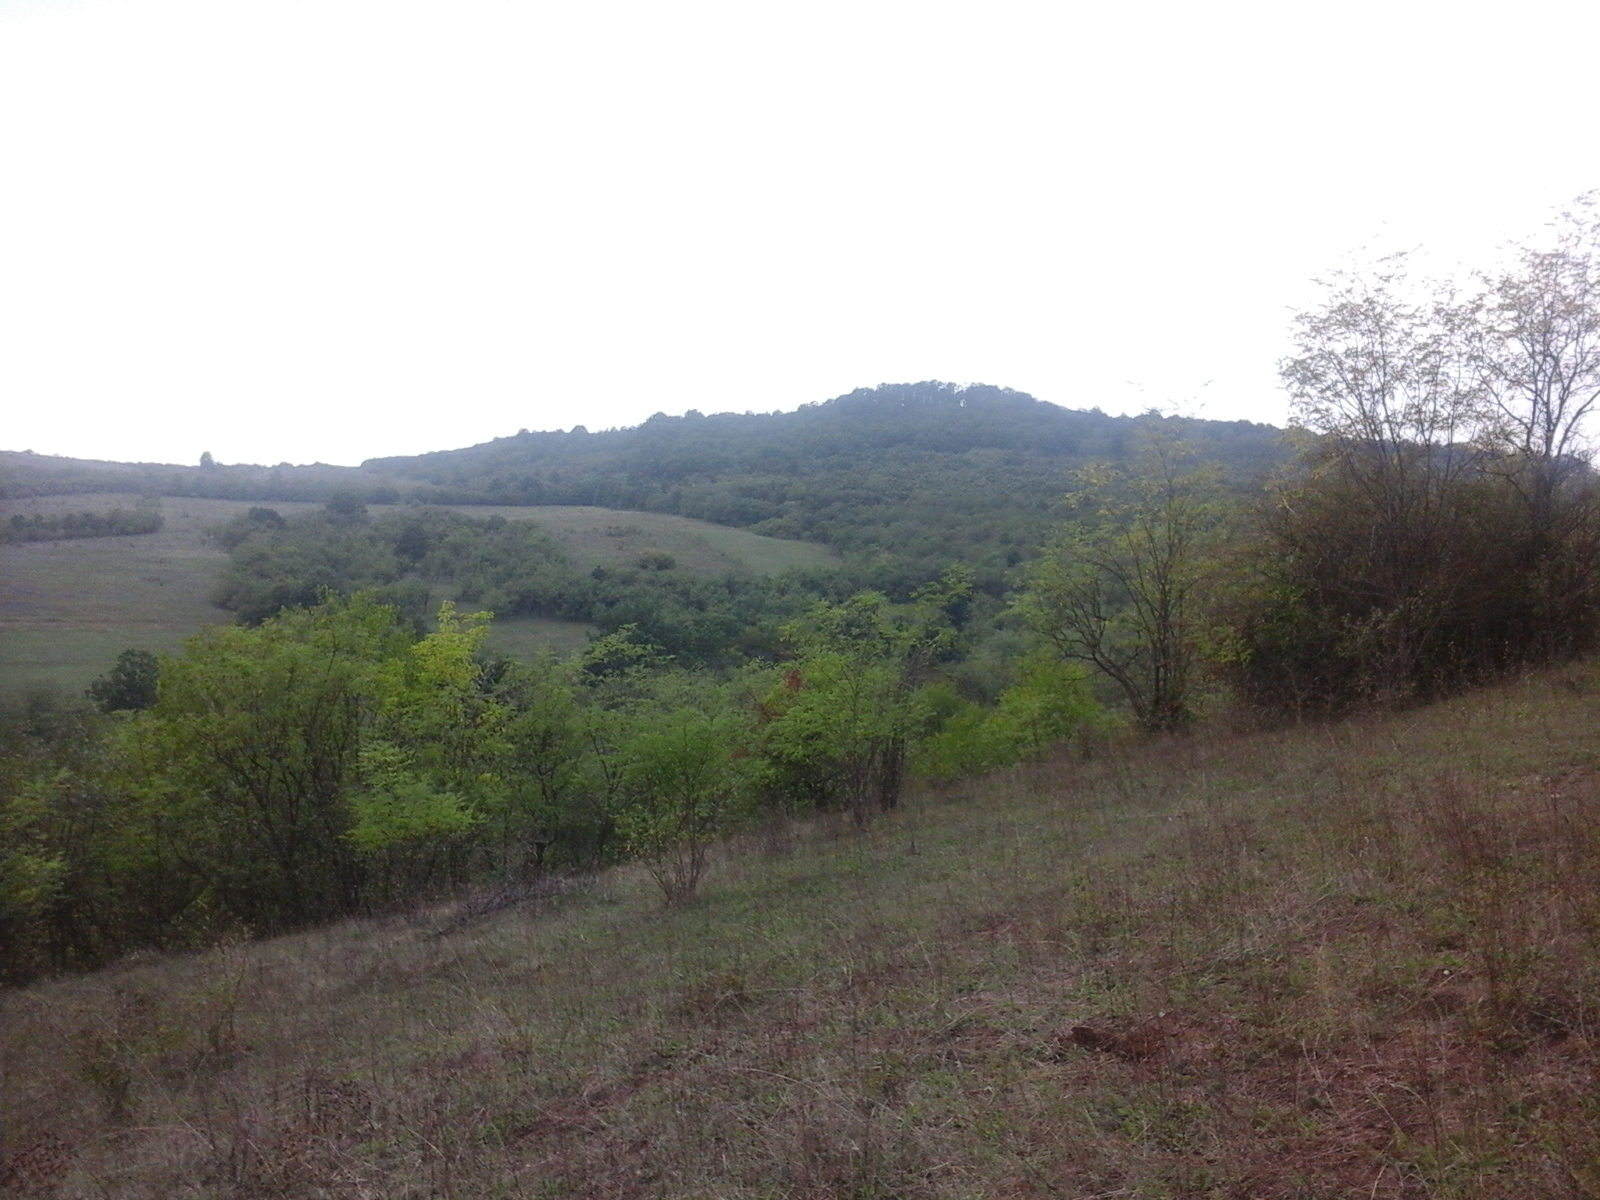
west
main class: Cropland
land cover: Other fruit trees and berries
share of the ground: > 75 %
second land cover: Grassland without tree/shrub cover
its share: > 75 %
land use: Agriculture (excluding fallow land and kitchen gardens)
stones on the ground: < 10 %
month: September
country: RO
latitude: 45.7576
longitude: 22.9749
